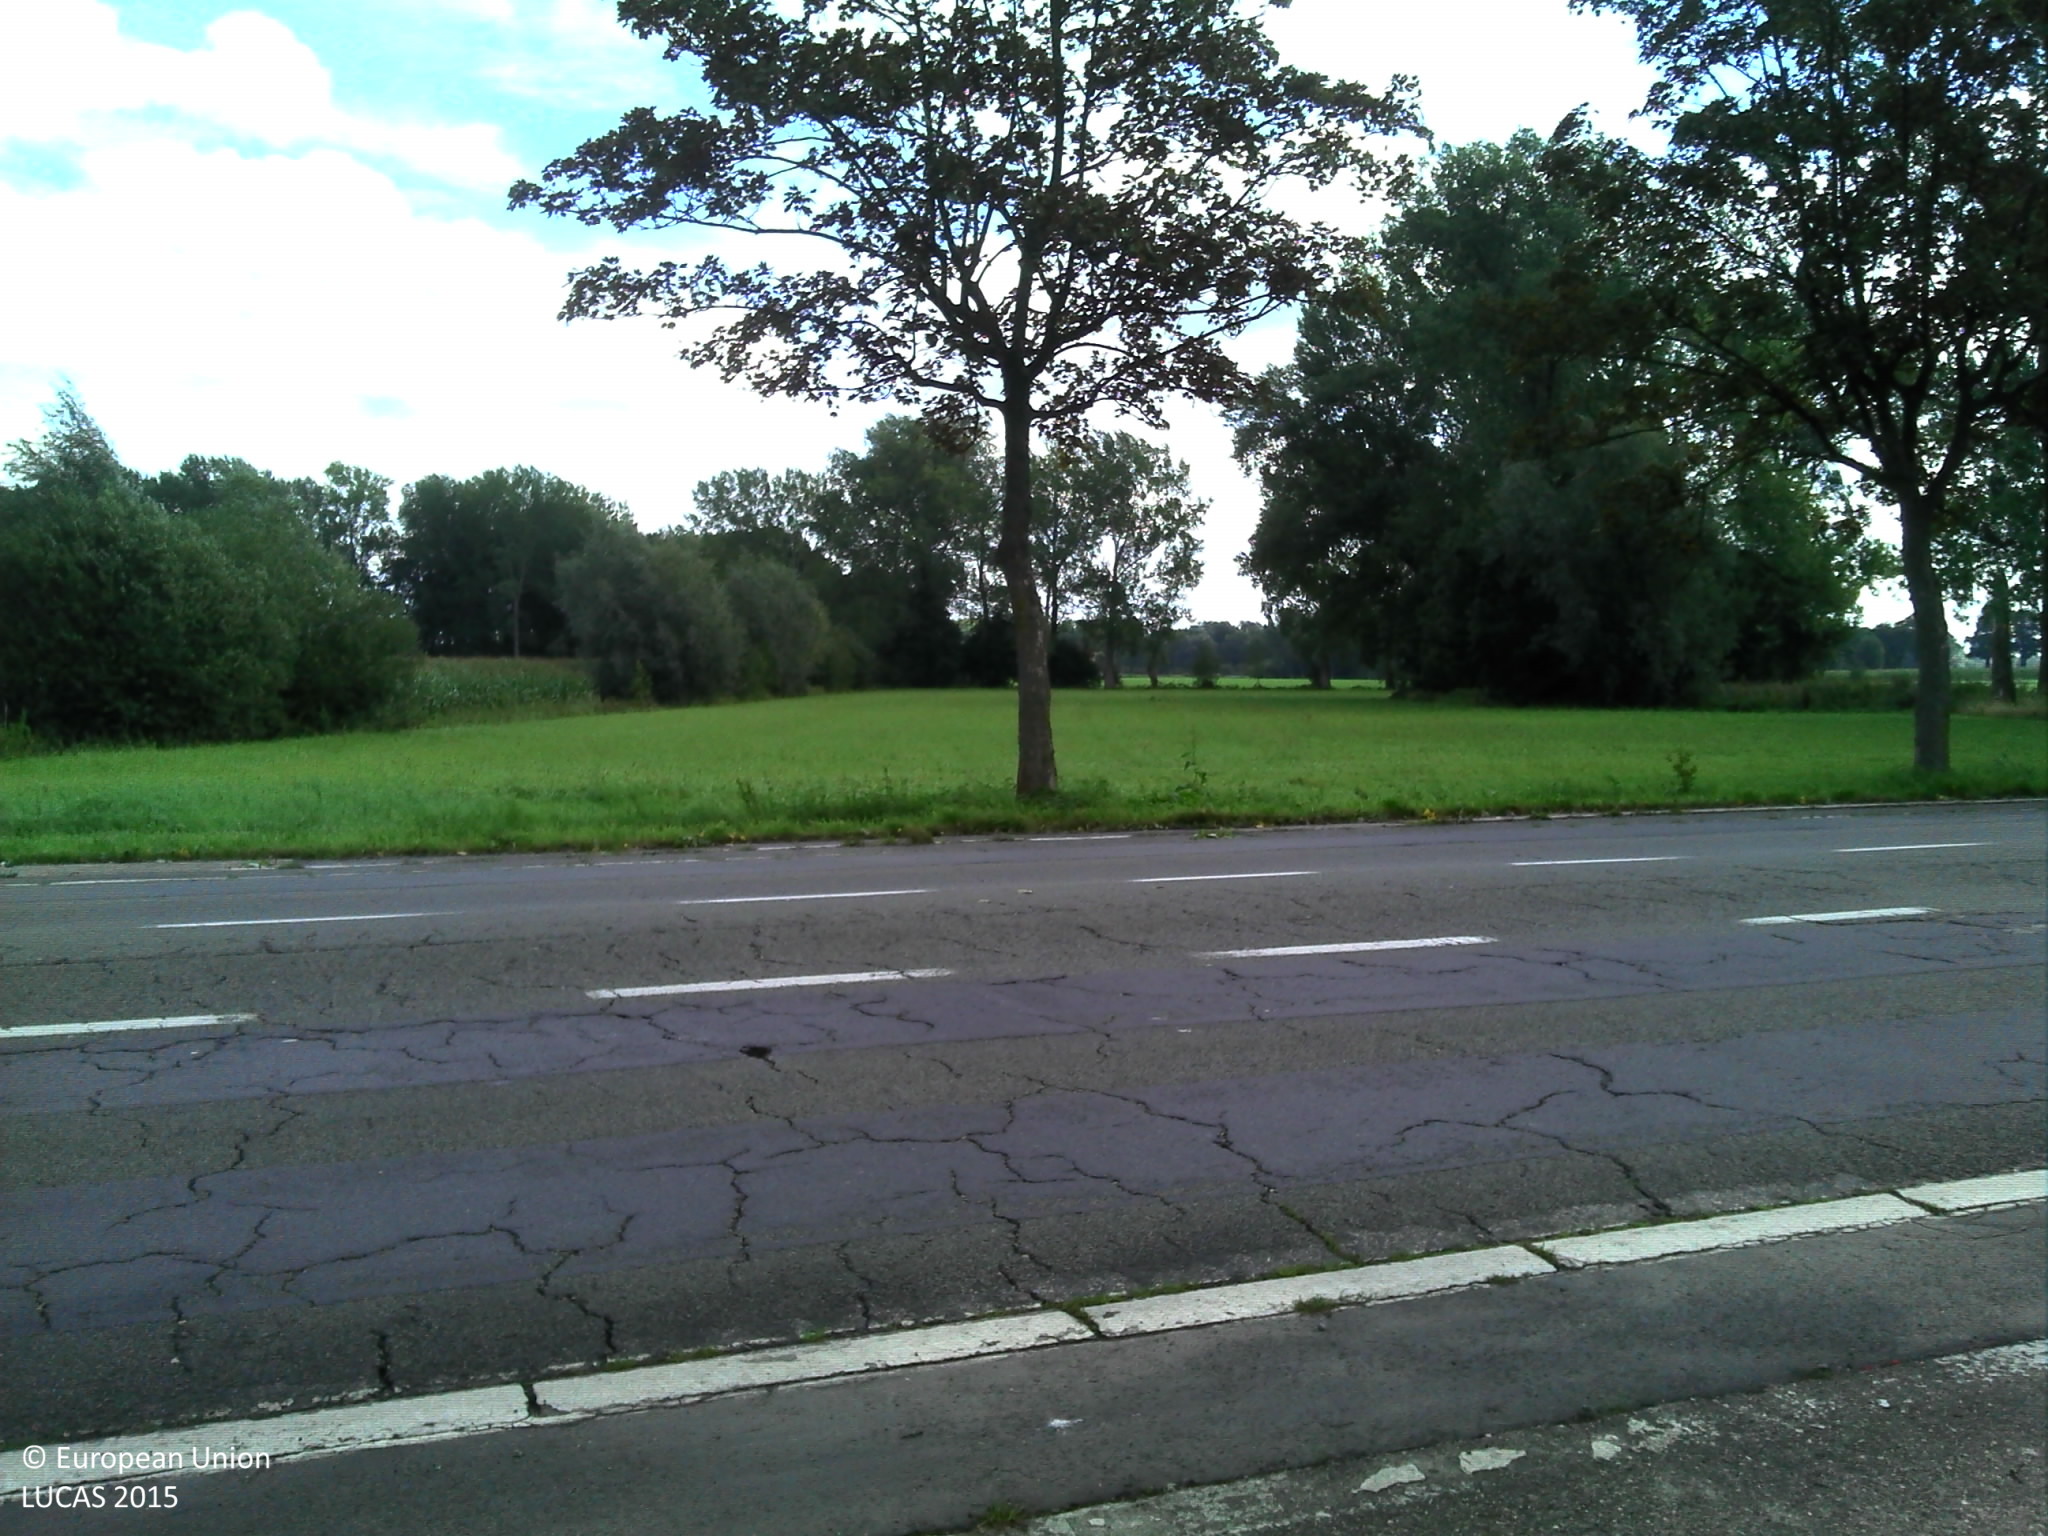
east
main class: Cropland
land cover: Maize
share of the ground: > 75 %
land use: Agriculture (excluding fallow land and kitchen gardens)
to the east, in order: Maize; Grass margins; Ditches and canals; Grass margins; Lines of trees; Paved roads, cycling and walking lanes; Lines of trees; Grass margins; Ditches and canals; Grass margins; Temporary grasslands; Lines of trees; Inland fresh running water; Grass margins; Lines of trees; Spontaneously vegetated surfaces; Lines of trees; Grass margins; Inland fresh running water; Grass margins; Temporary grasslands; Grass margins
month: September
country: BE
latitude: 51.1464
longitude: 4.4062
